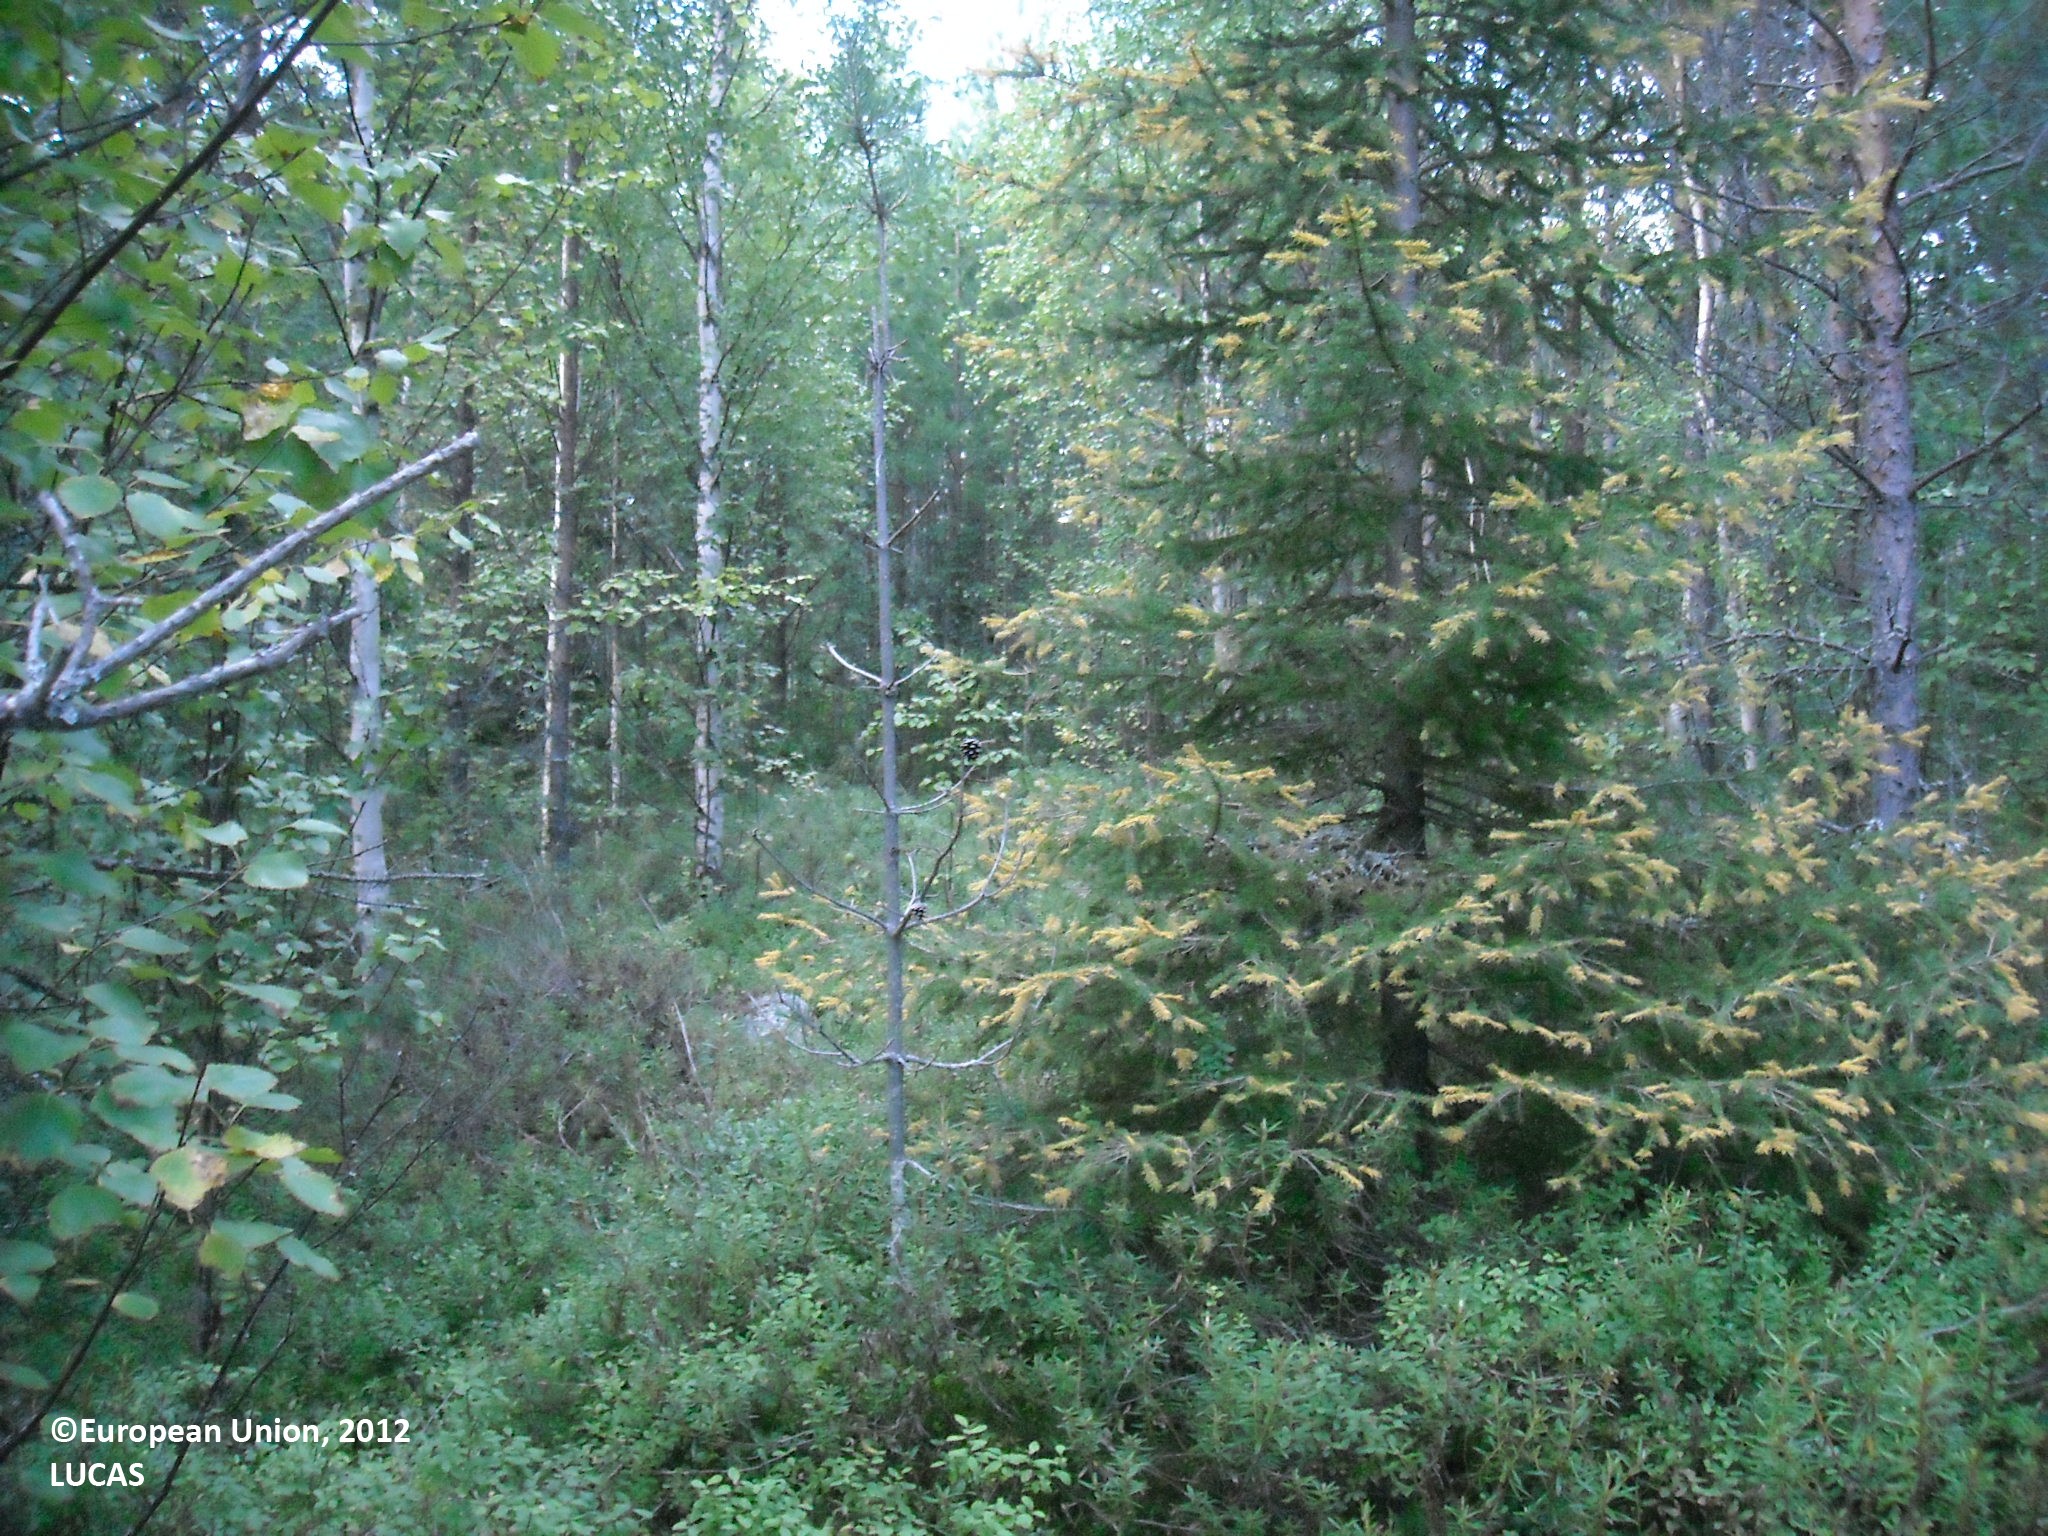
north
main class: Woodland
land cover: Other mixed woodland
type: boreal forest
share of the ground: > 75 %
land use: Forestry
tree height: > 5 m
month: August
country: FI
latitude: 65.1822
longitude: 27.6691
